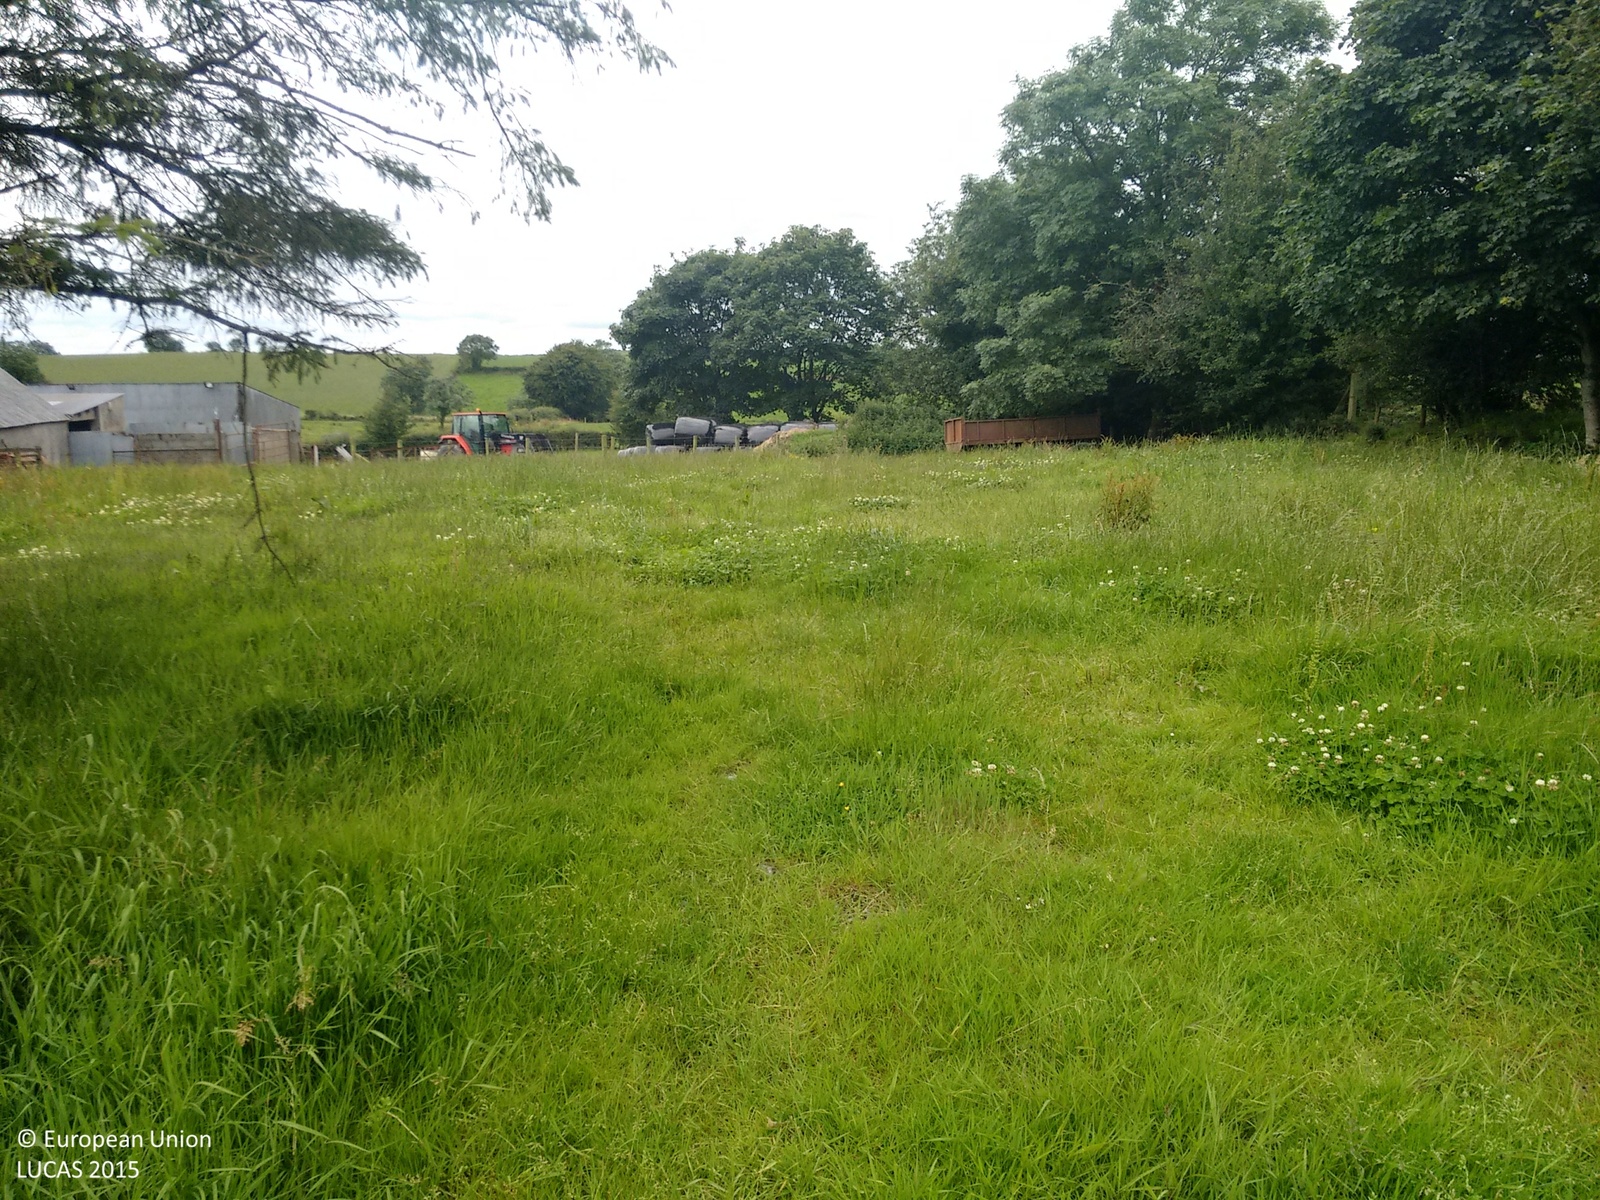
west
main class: Grassland
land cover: Grassland without tree/shrub cover
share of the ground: > 75 %
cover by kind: herbaceous plants 100 %
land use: Agriculture (excluding fallow land and kitchen gardens)
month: August
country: GB
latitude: 54.1579
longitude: -6.5901
